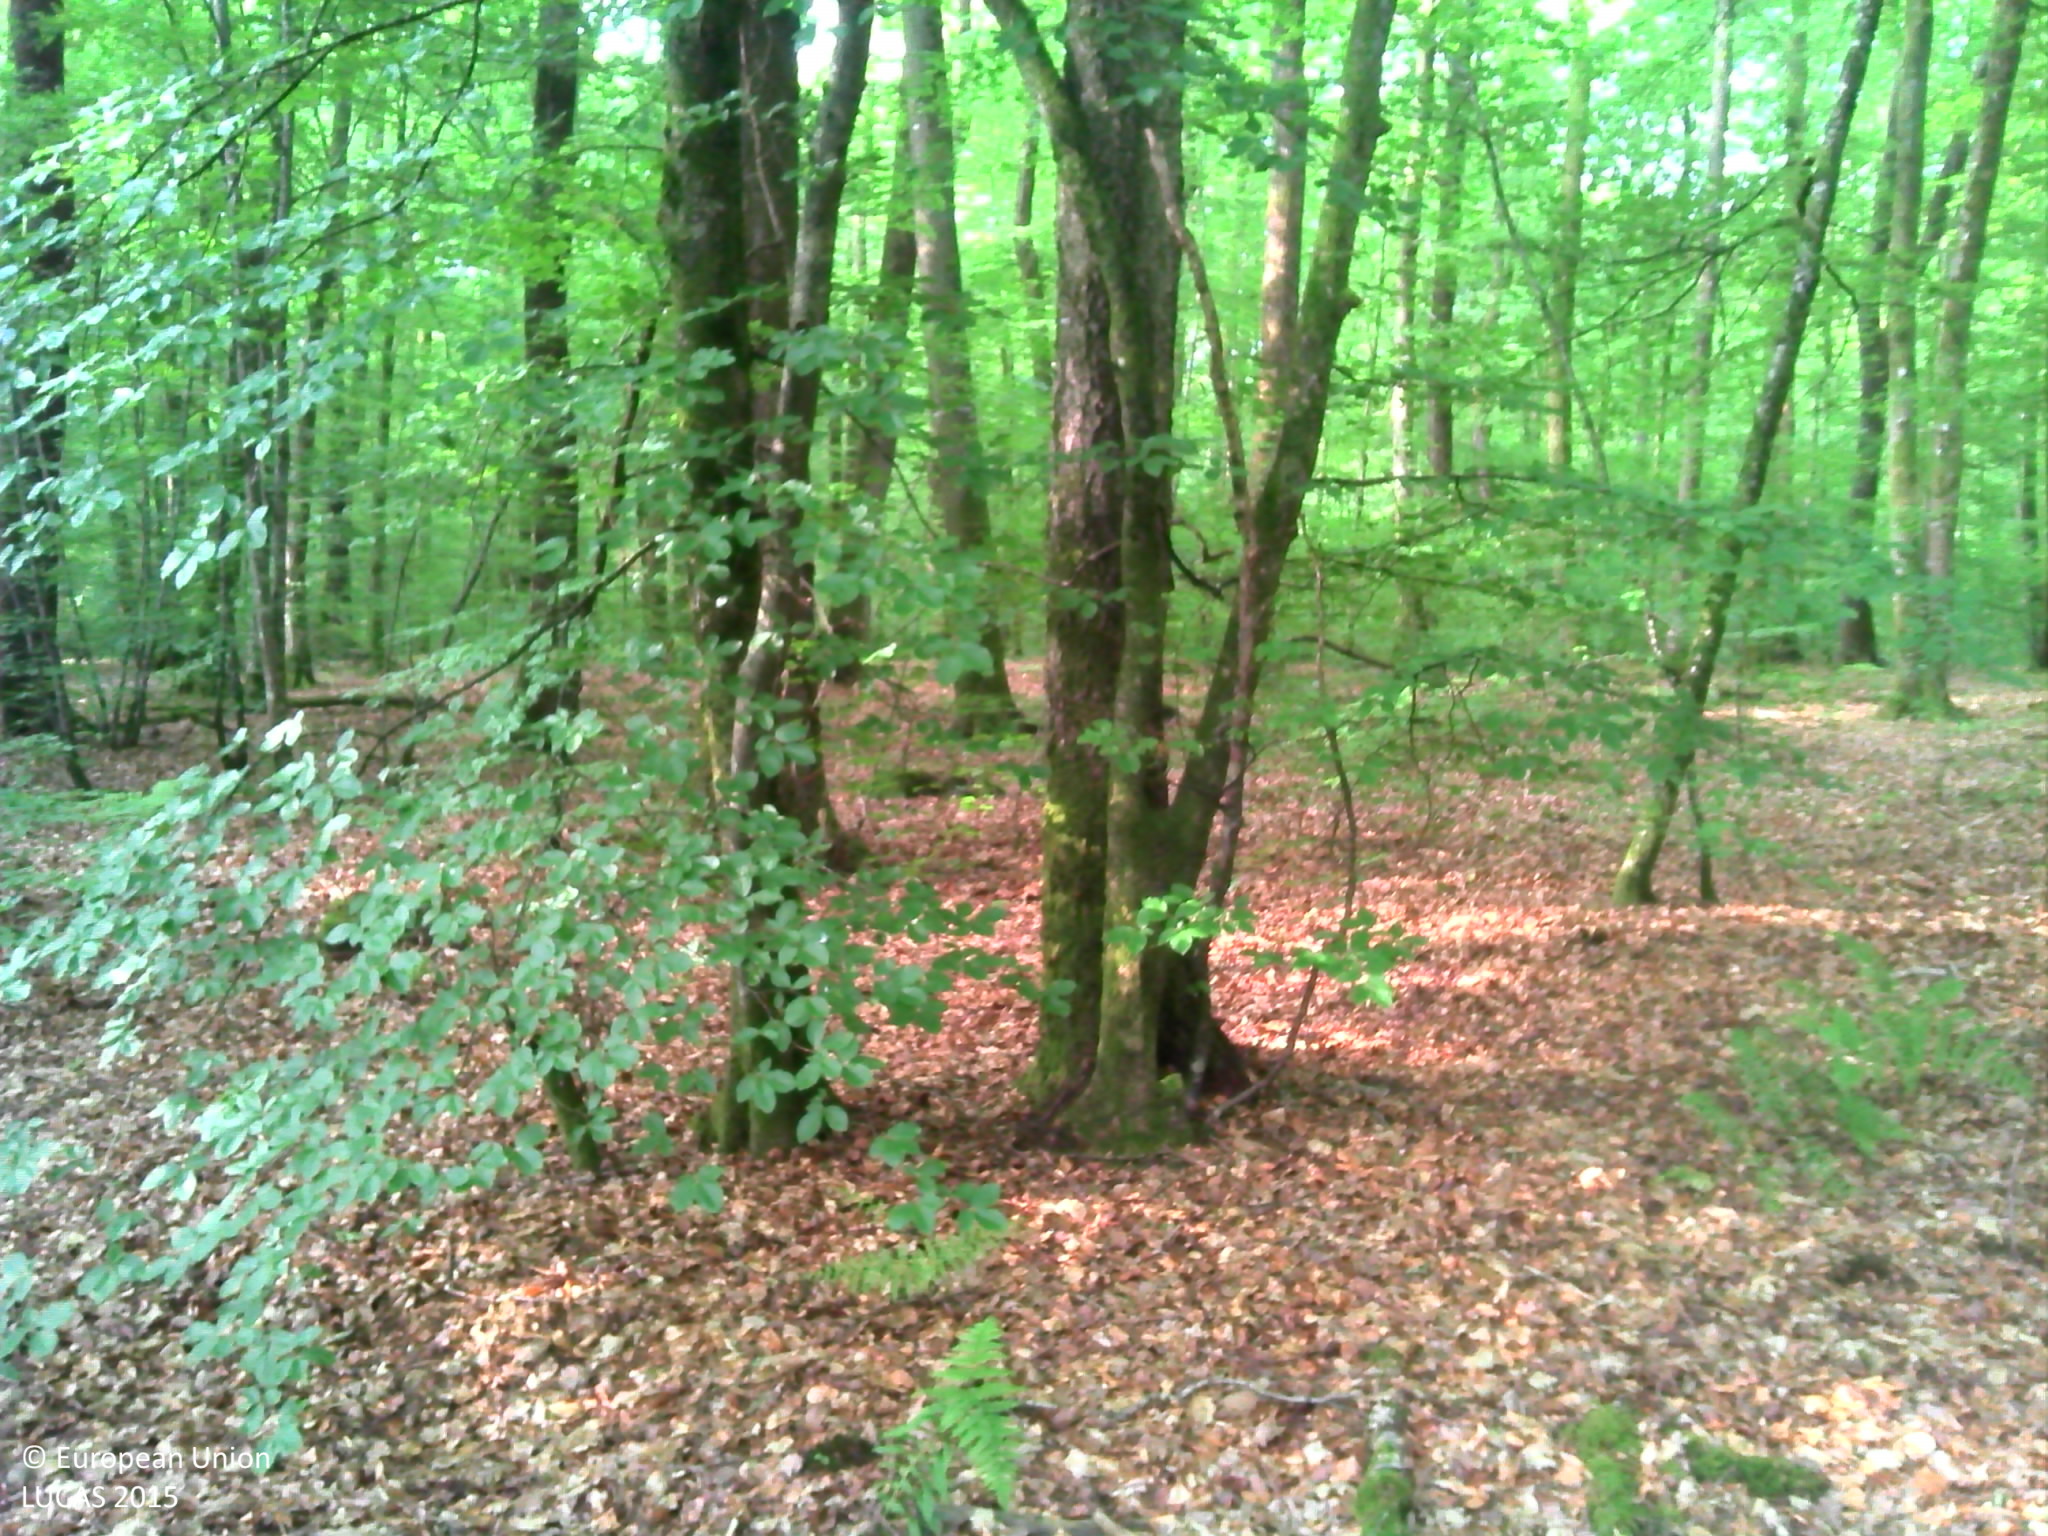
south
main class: Woodland
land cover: Broadleaved woodland
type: beech forest
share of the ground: > 75 %
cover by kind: broadleaved forest trees 95 %, herbaceous plants 5 %
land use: Forestry
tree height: > 5 m
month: June
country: FR
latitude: 47.8308
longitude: 6.1134
